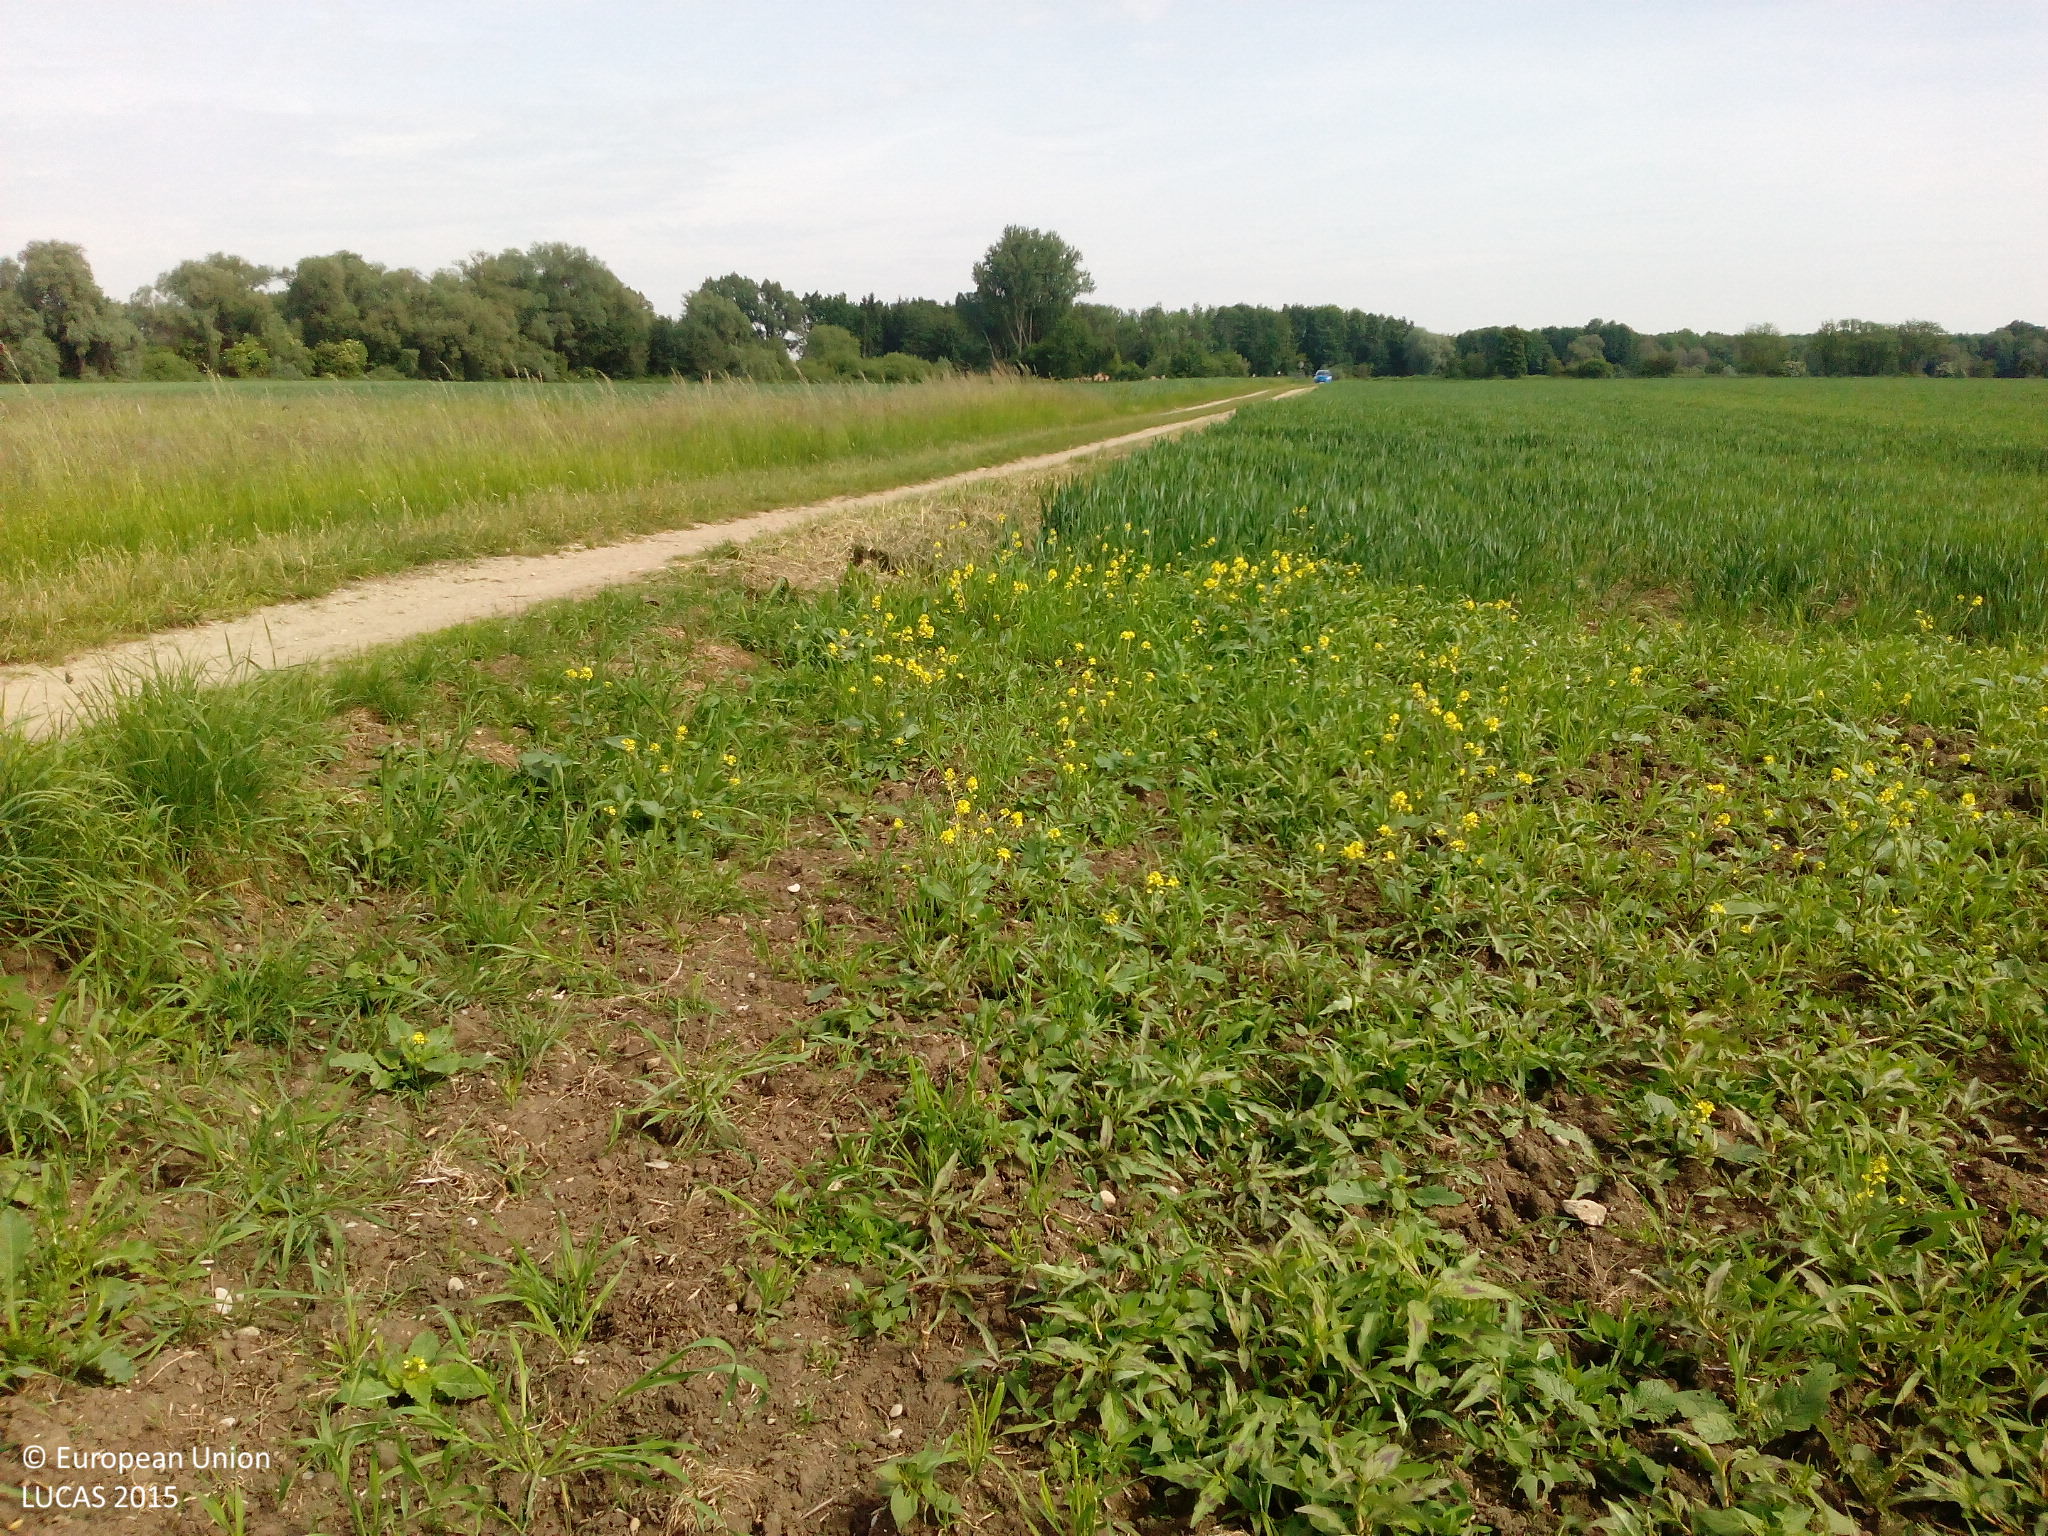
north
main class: Grassland
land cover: Spontaneously vegetated surfaces
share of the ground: 25 - 50 %
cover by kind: unconsolidated bare surface 60 %, herbaceous plants 40 %
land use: Agriculture (excluding fallow land and kitchen gardens)
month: May
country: DE
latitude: 48.6995
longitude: 11.4803
